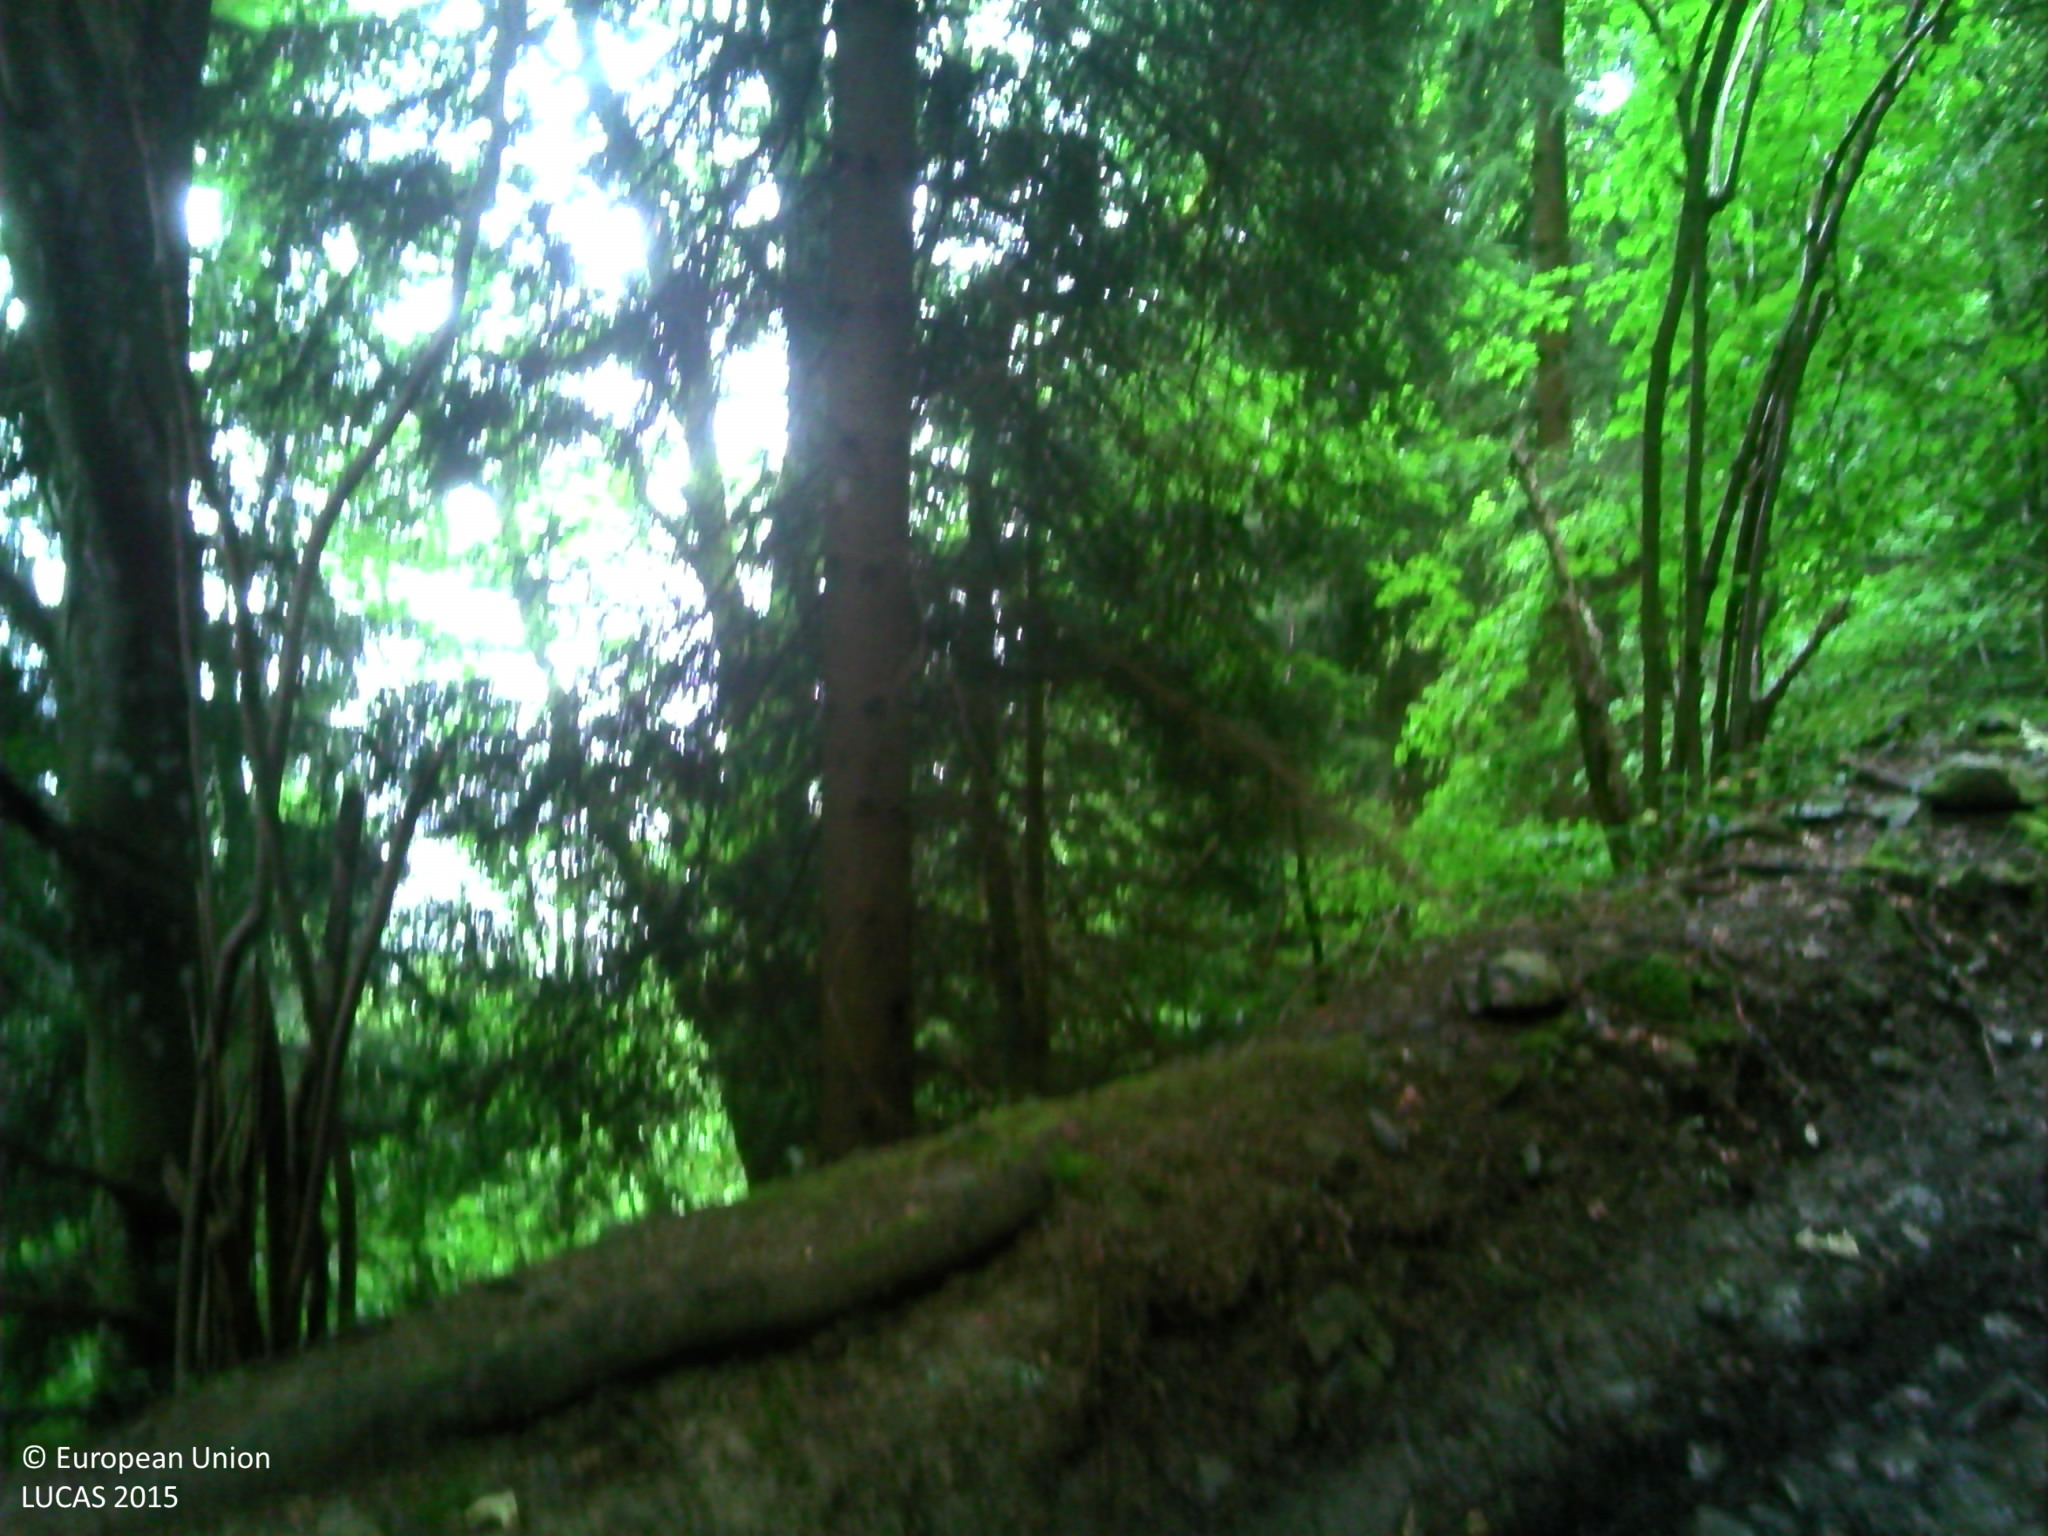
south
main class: Woodland
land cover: Spruce dominated coniferous woodland
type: alpine coniferous forest
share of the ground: > 75 %
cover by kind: coniferous forest trees 70 %, broadleaved forest trees 15 %, herbaceous plants 10 %, lichens and mosses 5 %
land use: Forestry
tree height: > 5 m
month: July
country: FR
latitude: 45.9420
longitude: 6.2245
